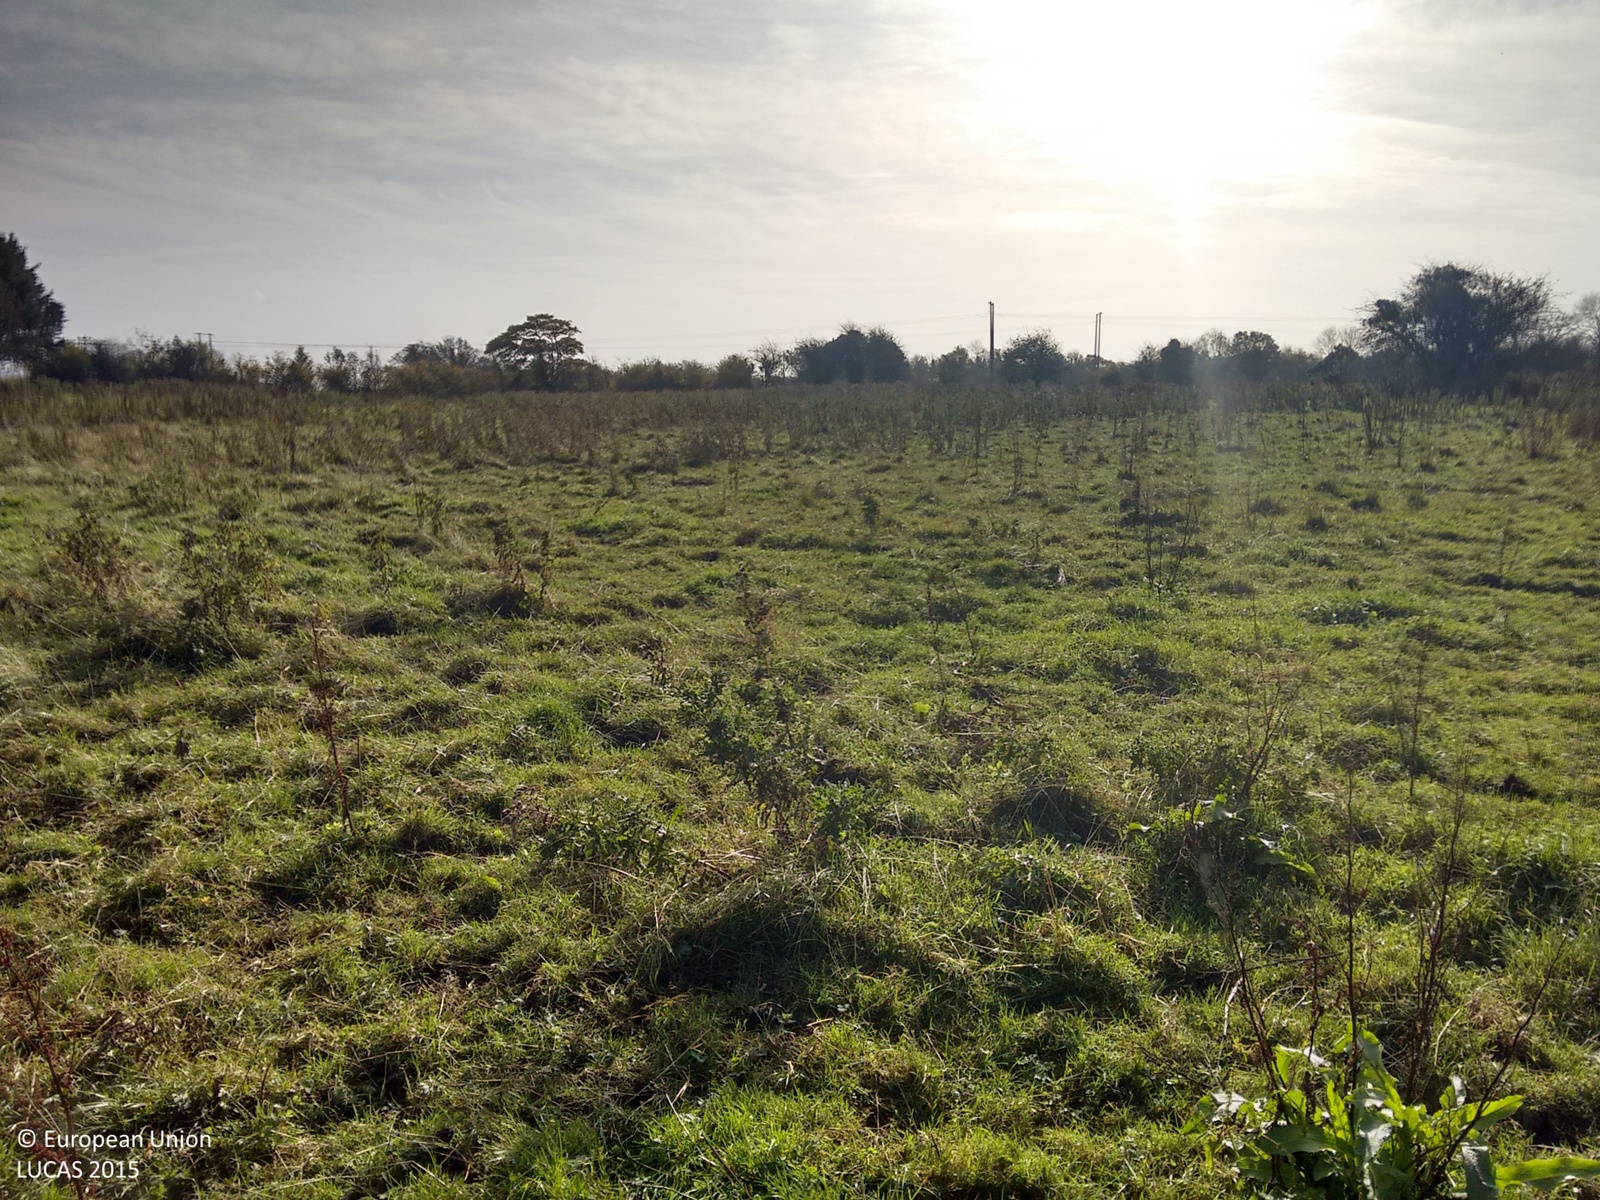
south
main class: Grassland
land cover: Grassland without tree/shrub cover
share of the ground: > 75 %
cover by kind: herbaceous plants 95 %, shrubs 5 %
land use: Agriculture (excluding fallow land and kitchen gardens)
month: October
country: IE
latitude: 53.2247
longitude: -7.8292
